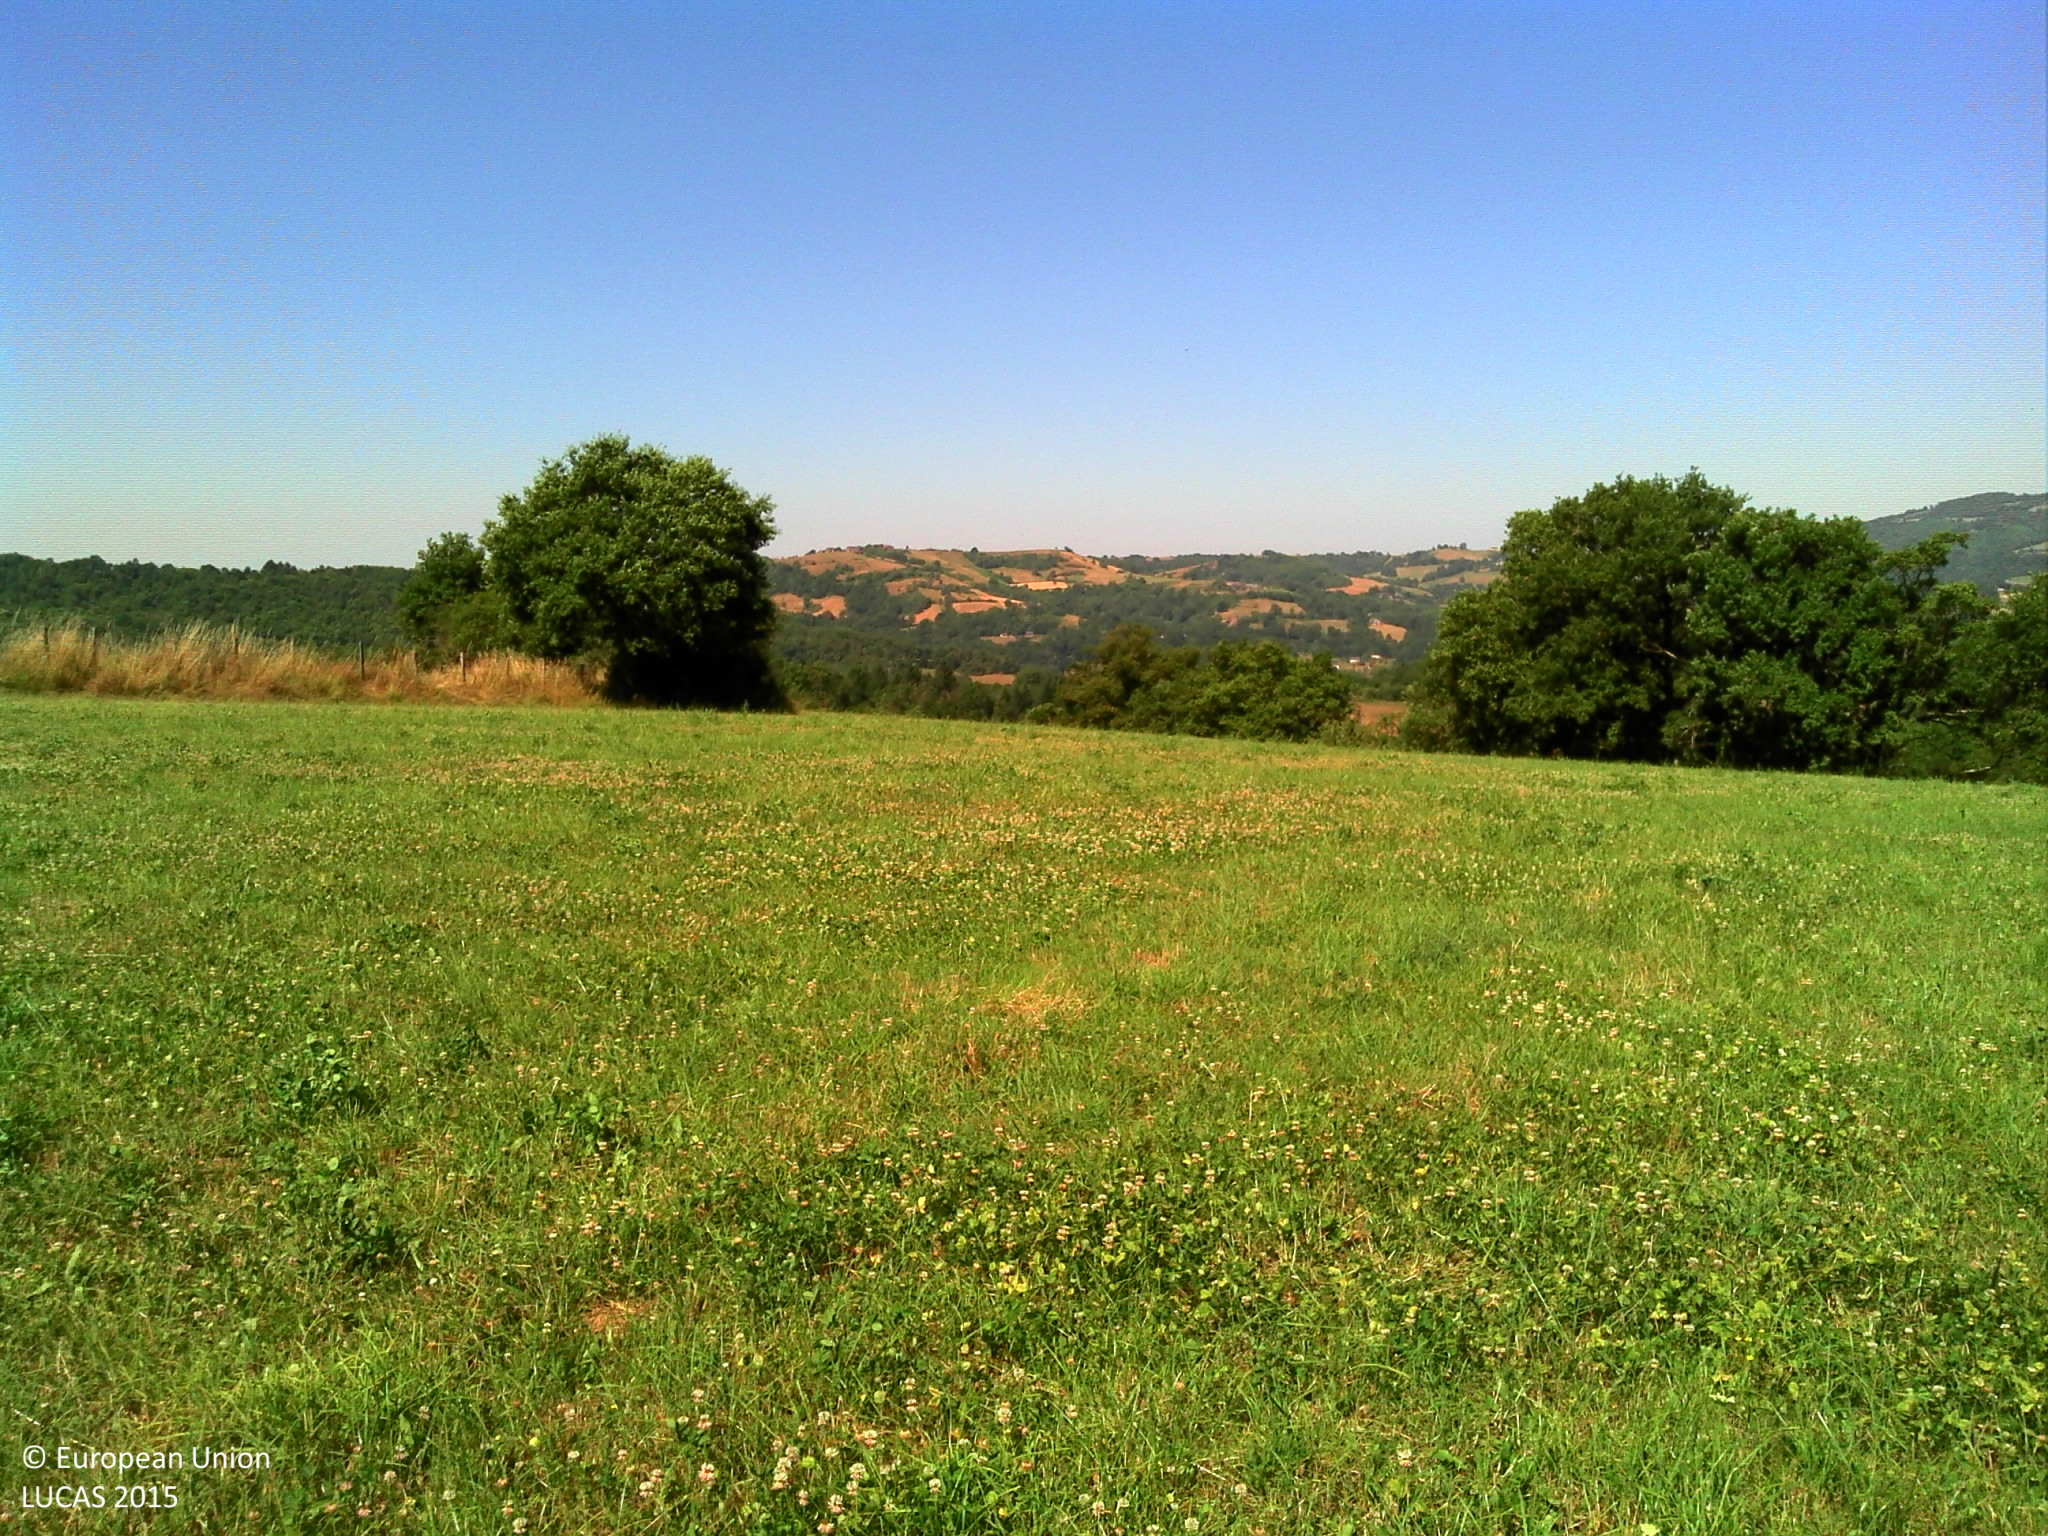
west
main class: Grassland
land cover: Grassland without tree/shrub cover
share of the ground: > 75 %
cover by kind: herbaceous plants 100 %
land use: Agriculture (excluding fallow land and kitchen gardens)
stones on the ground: < 10 %
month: June
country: FR
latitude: 44.5451
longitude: 2.4375
